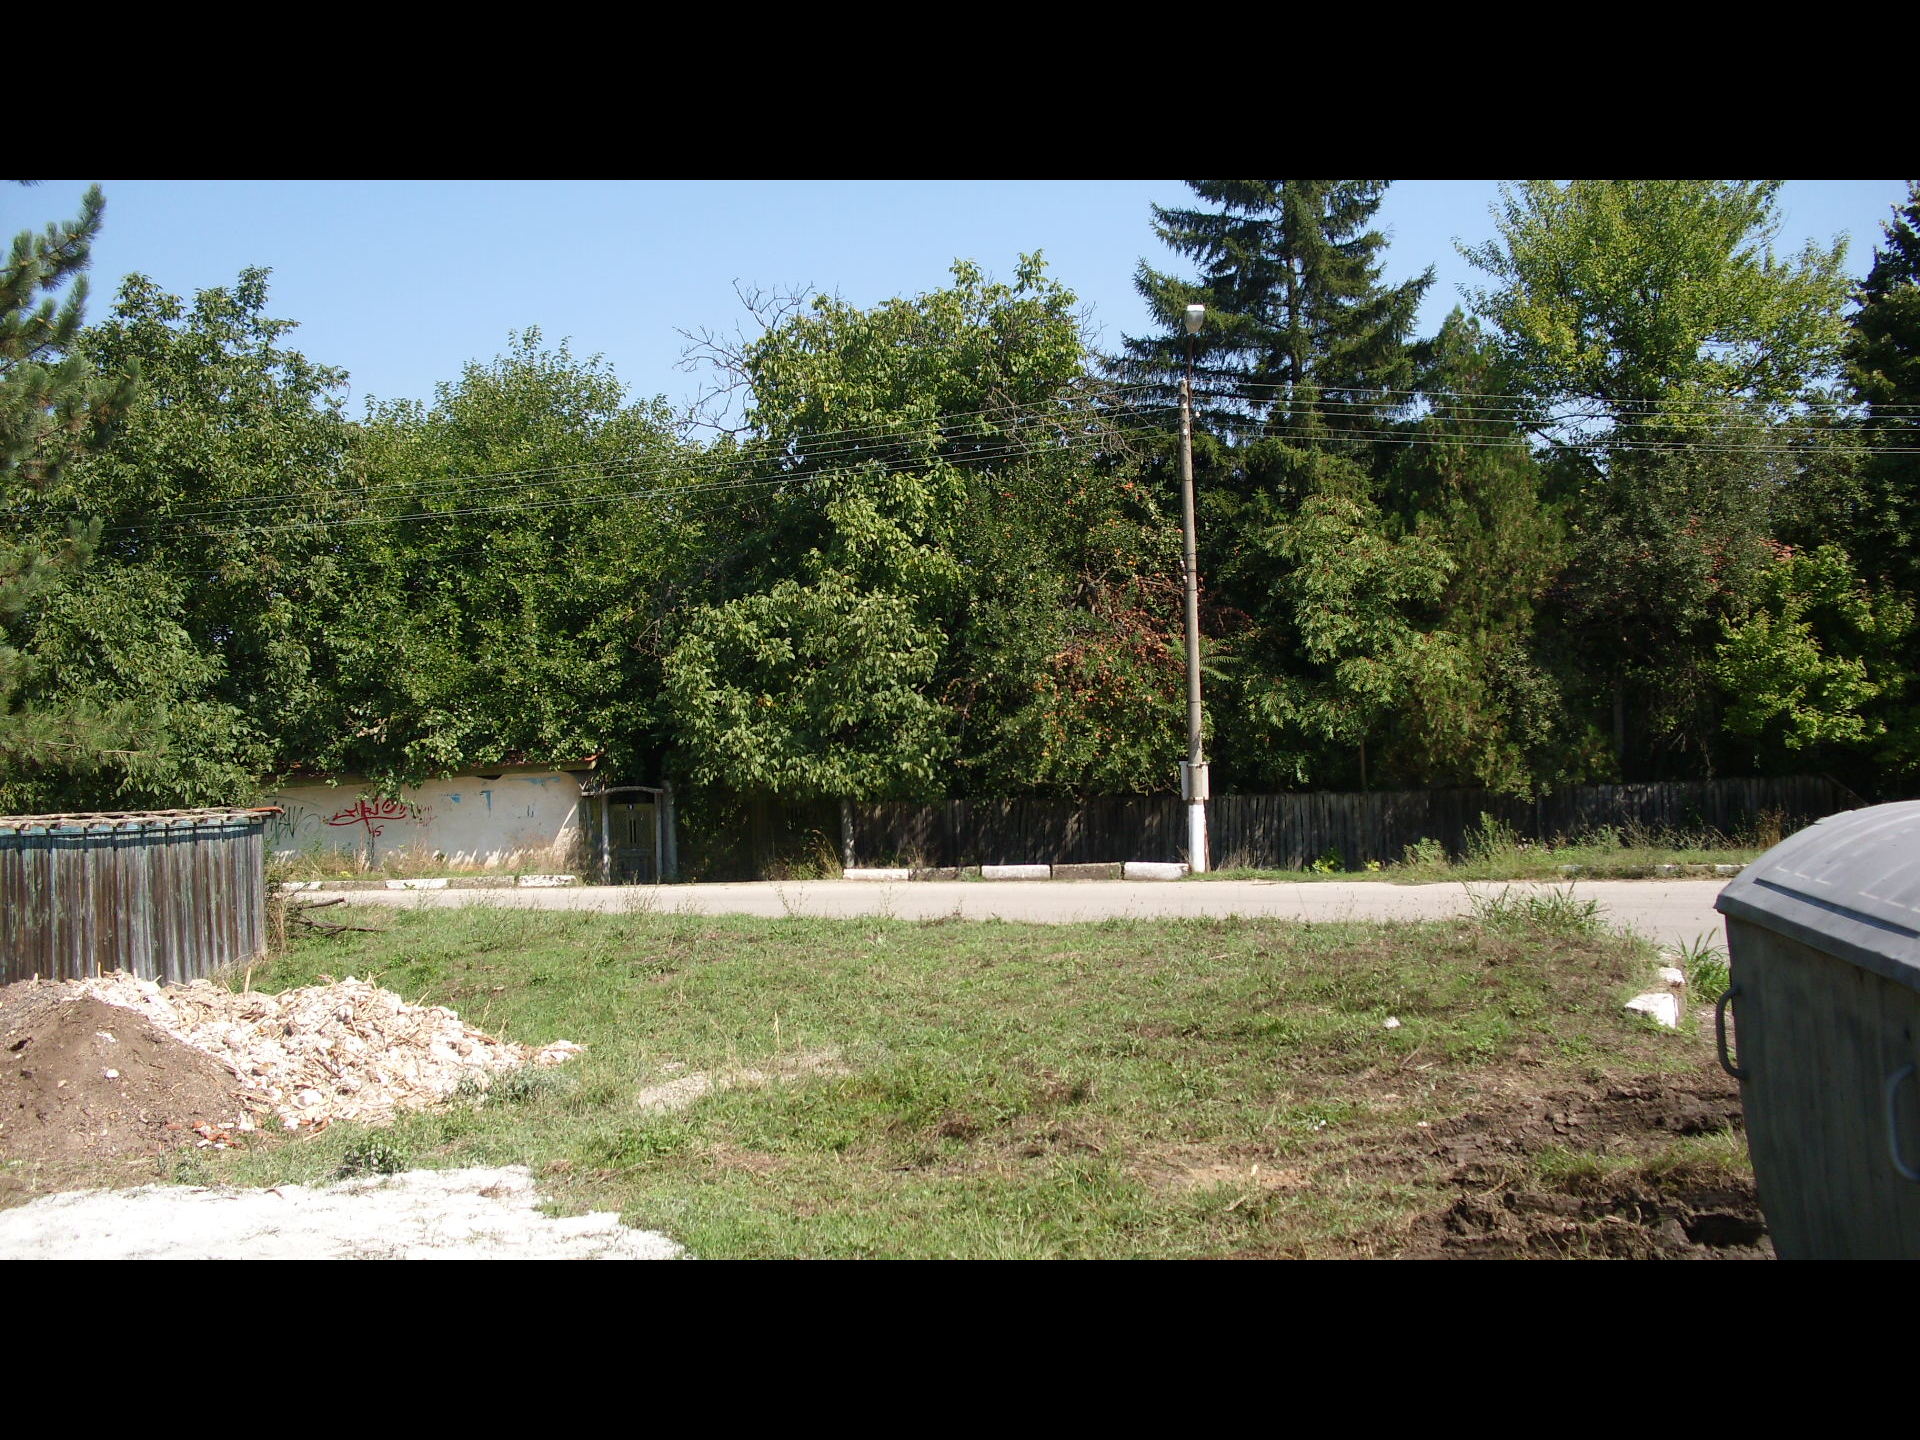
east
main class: Grassland
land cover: Grassland with sparse tree/shrub cover
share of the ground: > 75 %
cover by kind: herbaceous plants 90 %, broadleaved forest trees 5 %, shrubs 5 %
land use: Residential
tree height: > 5 m
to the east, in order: Grassland with sparse tree/shrub cover; Artificial constructions in urban areas
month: August
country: BG
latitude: 44.1206
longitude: 22.6461
